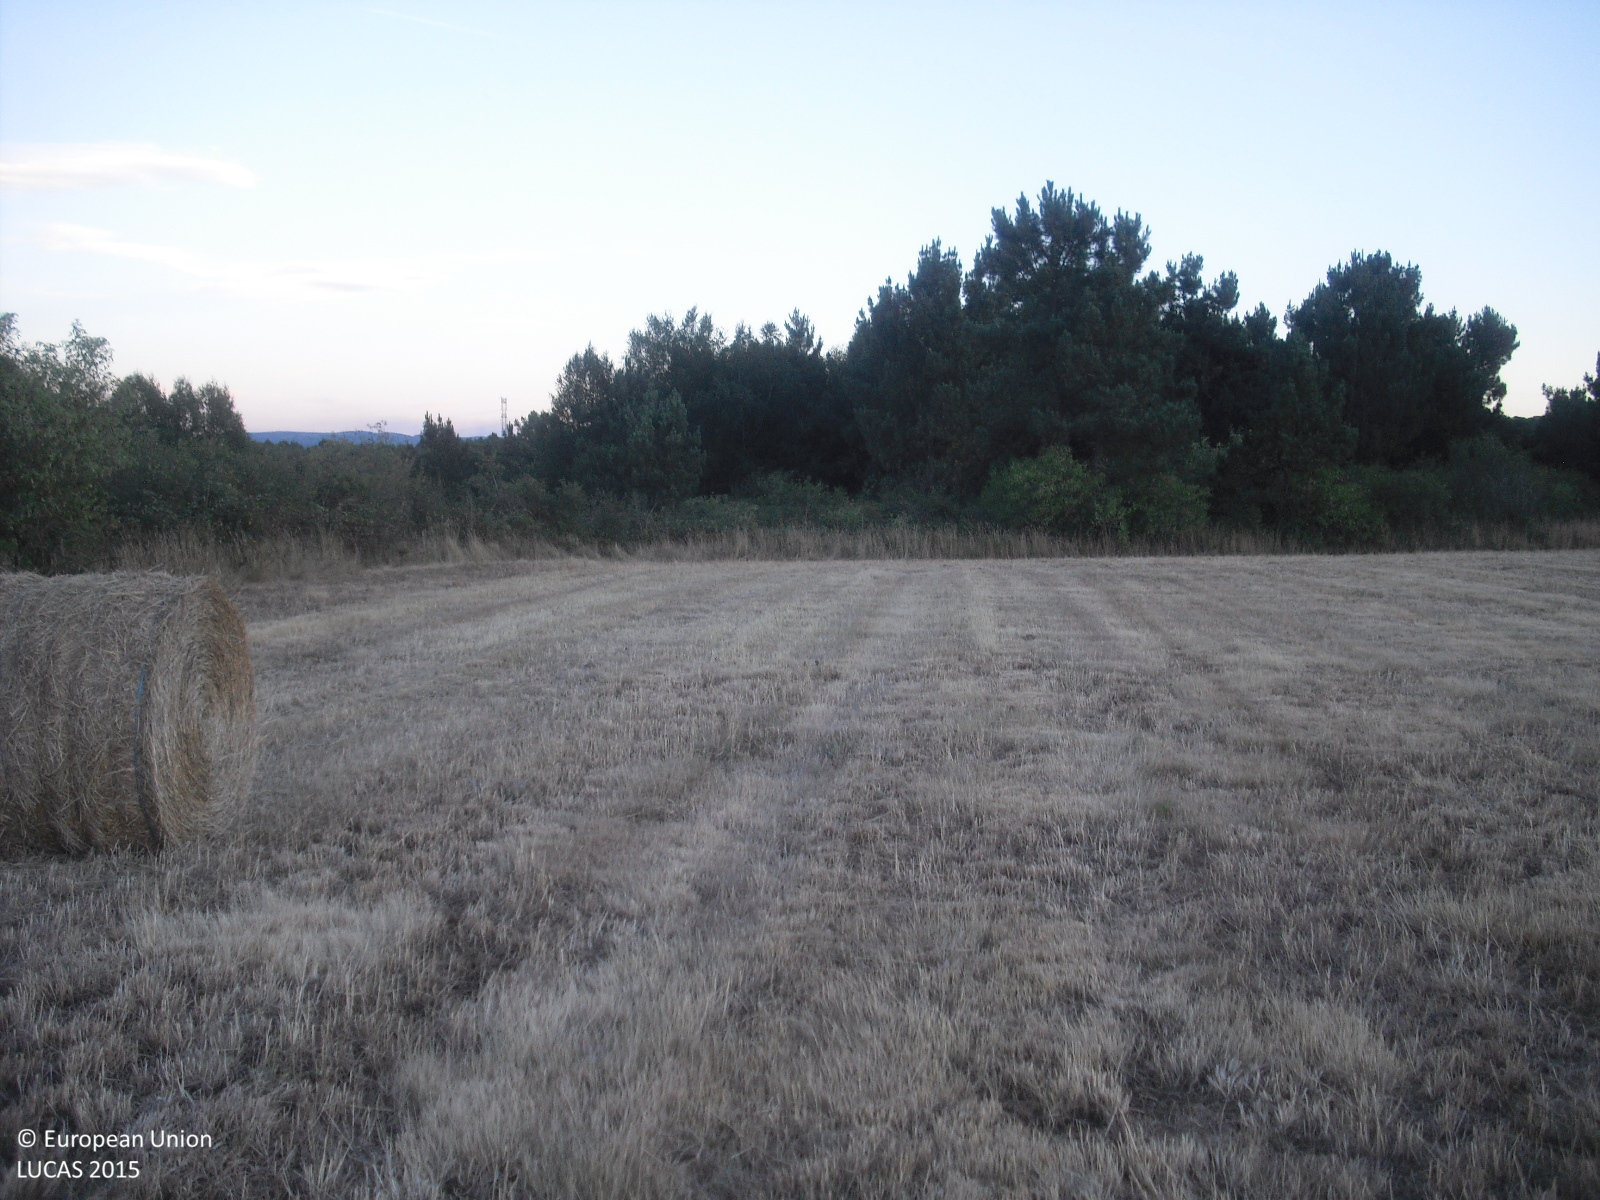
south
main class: Cropland
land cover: Temporary grasslands
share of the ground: > 75 %
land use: Agriculture (excluding fallow land and kitchen gardens)
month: July
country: ES
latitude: 42.2893
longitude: -7.6436
